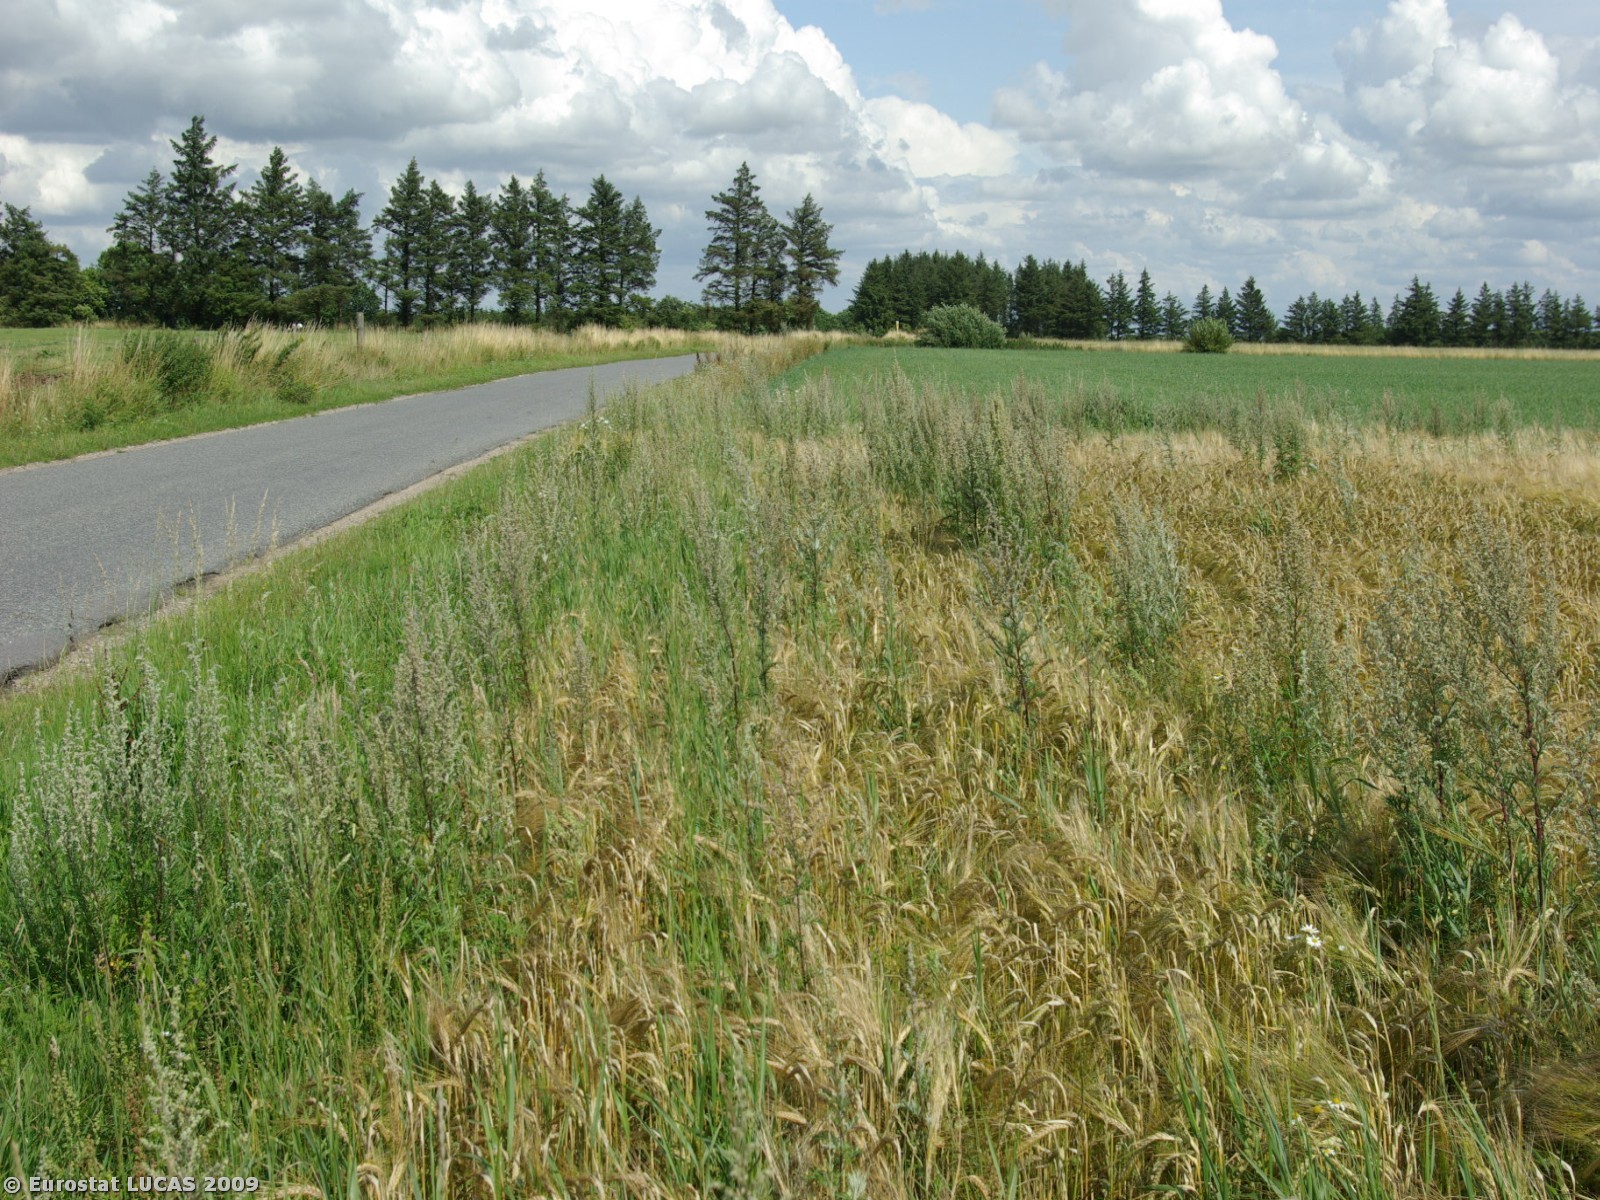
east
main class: Cropland
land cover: Barley
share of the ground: > 75 %
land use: Agriculture (excluding fallow land and kitchen gardens)
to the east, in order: Barley; Grass margins; Temporary grasslands; Grass margins; Ditches and canals; Grass margins; Other leguminous and mixtures for fodder; Barley
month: July
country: DK
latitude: 55.0507
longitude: 8.9208
